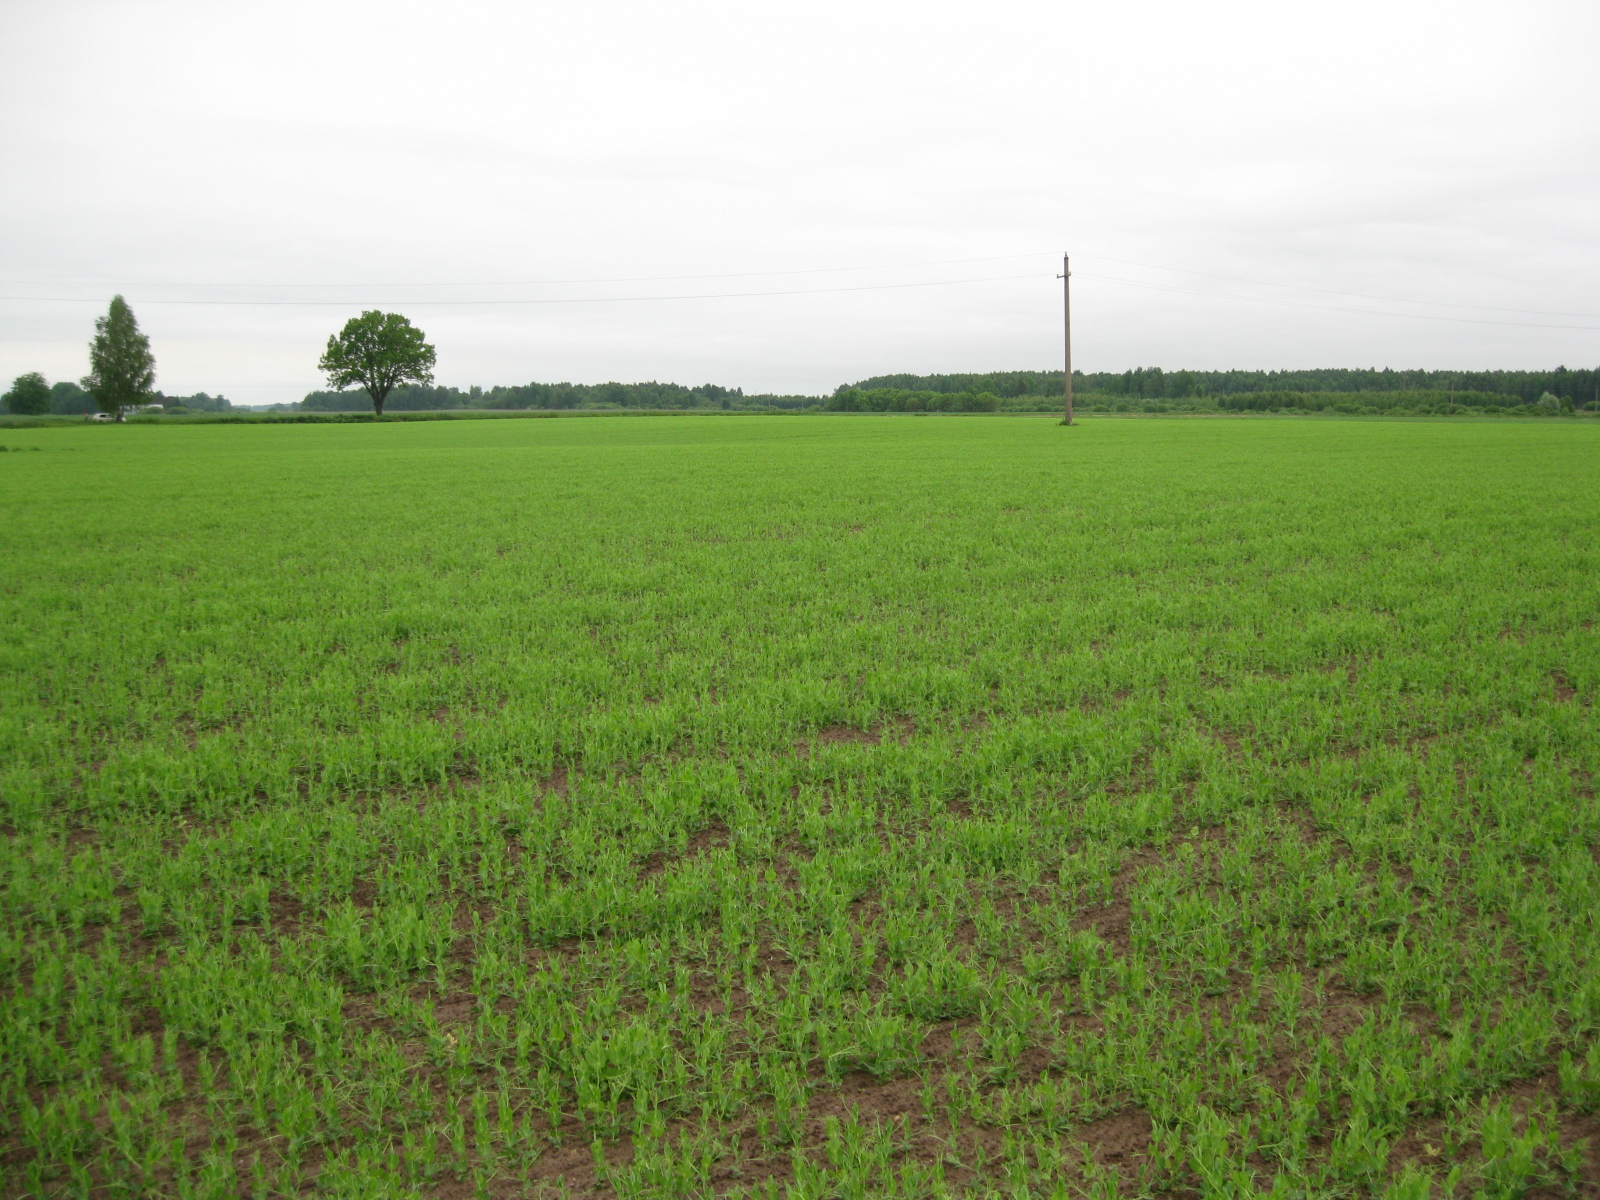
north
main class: Cropland
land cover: Dry pulses
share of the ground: 50 - 75 %
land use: Agriculture (excluding fallow land and kitchen gardens)
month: June
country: LT
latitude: 55.8677
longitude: 24.0392
